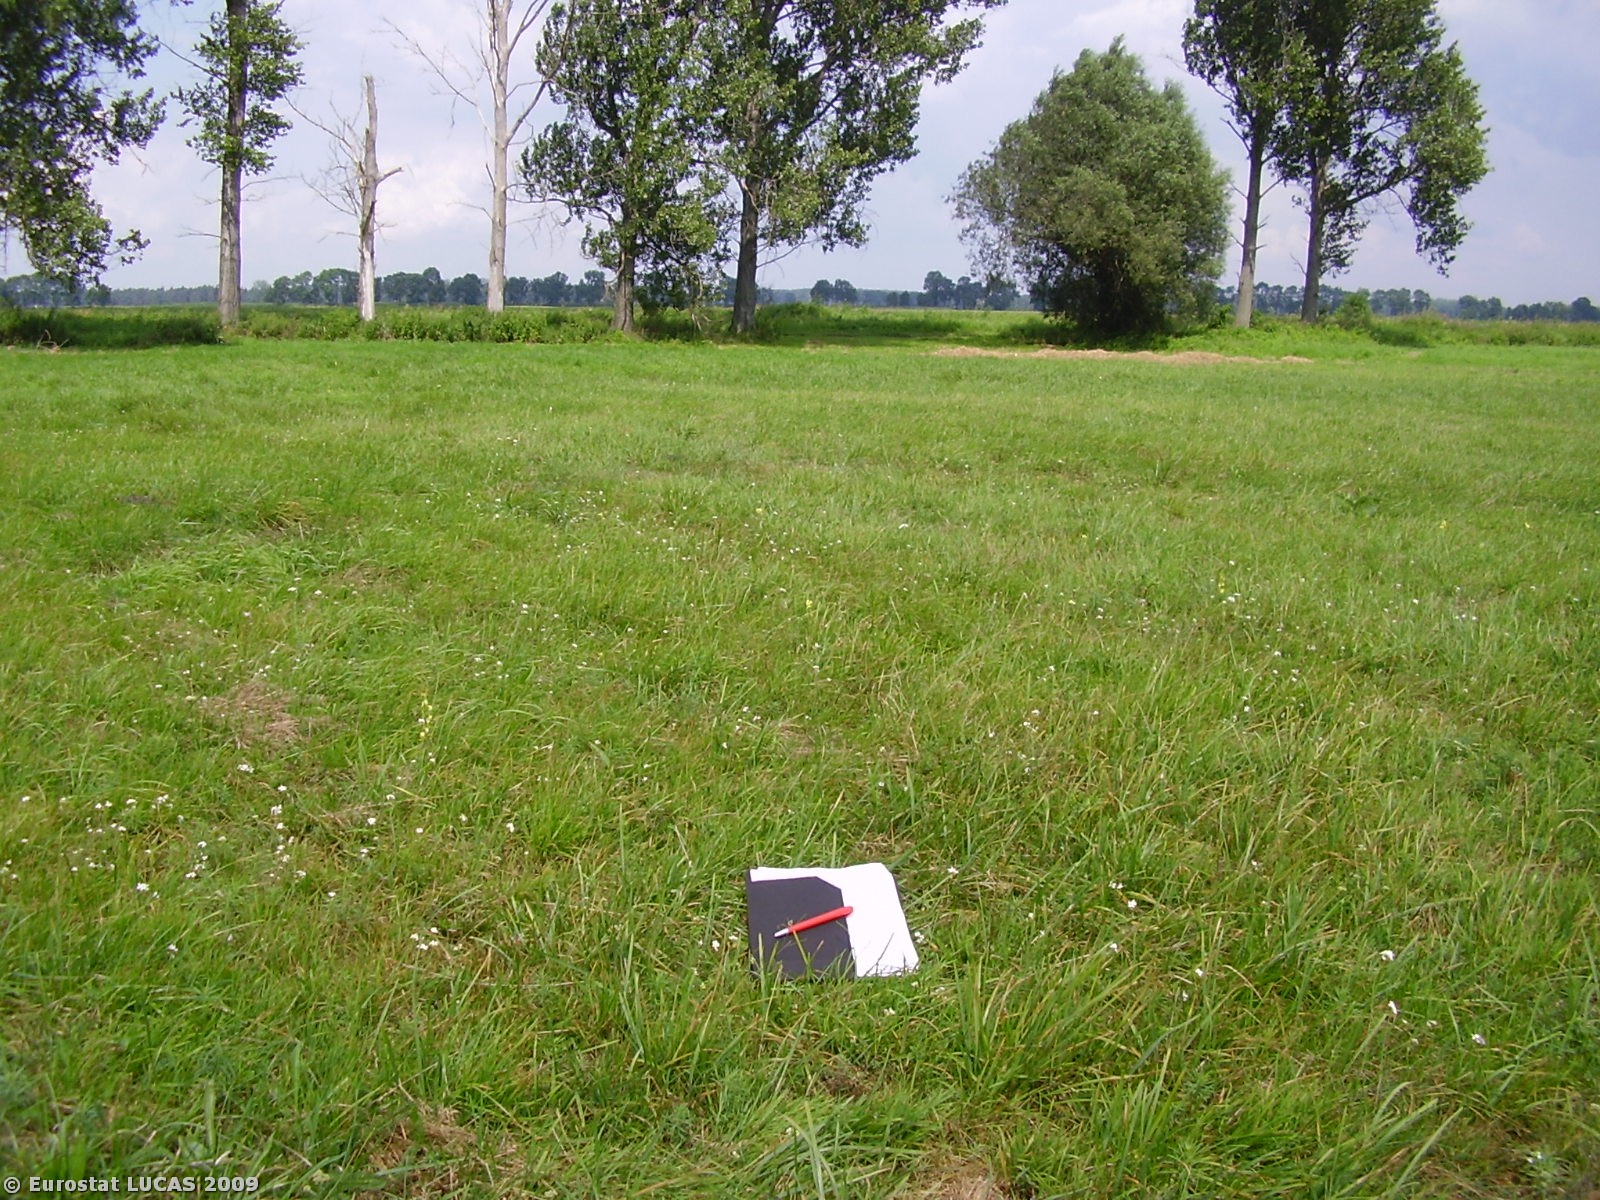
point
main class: Grassland
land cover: Grassland without tree/shrub cover
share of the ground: > 75 %
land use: Agriculture (excluding fallow land and kitchen gardens)
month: July
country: PL
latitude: 52.0499
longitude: 16.2624
